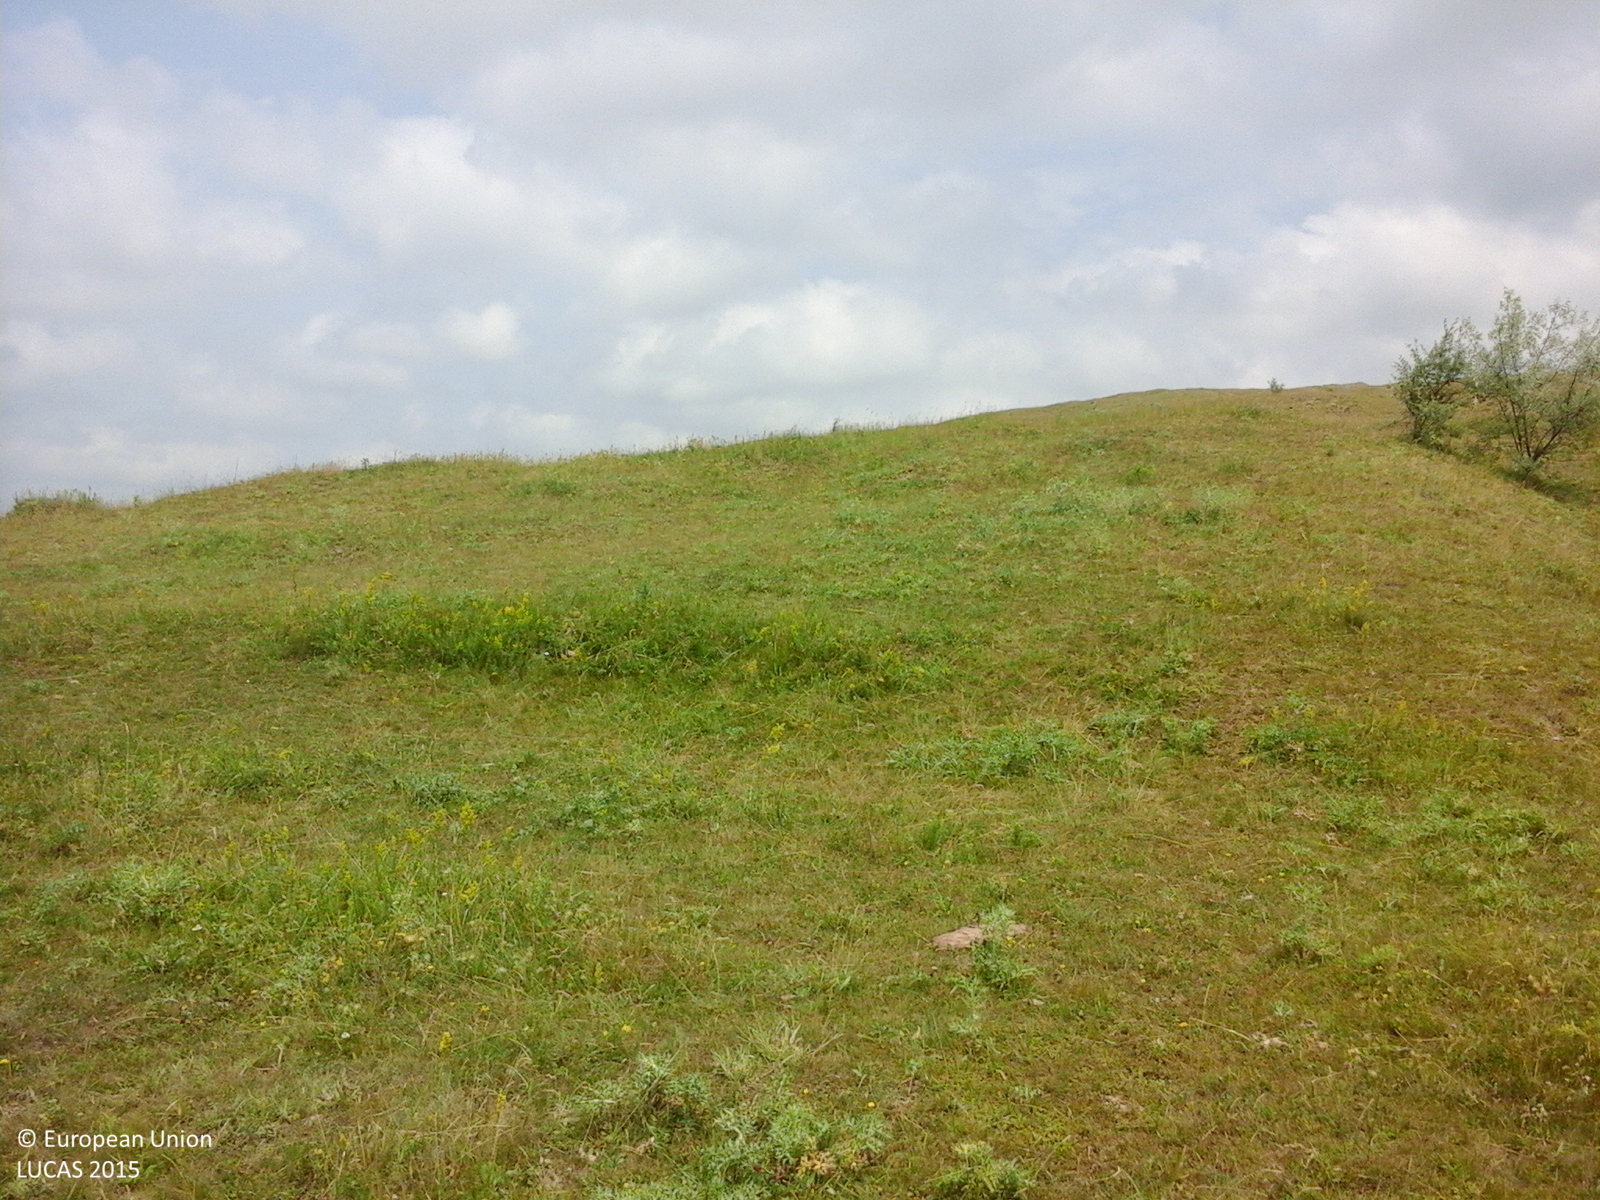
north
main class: Grassland
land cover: Grassland with sparse tree/shrub cover
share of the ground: > 75 %
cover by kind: herbaceous plants 85 %, shrubs 10 %, broadleaved forest trees 5 %
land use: Agriculture (excluding fallow land and kitchen gardens)
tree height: < 5 m
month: June
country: RO
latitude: 47.7645
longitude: 26.4603
